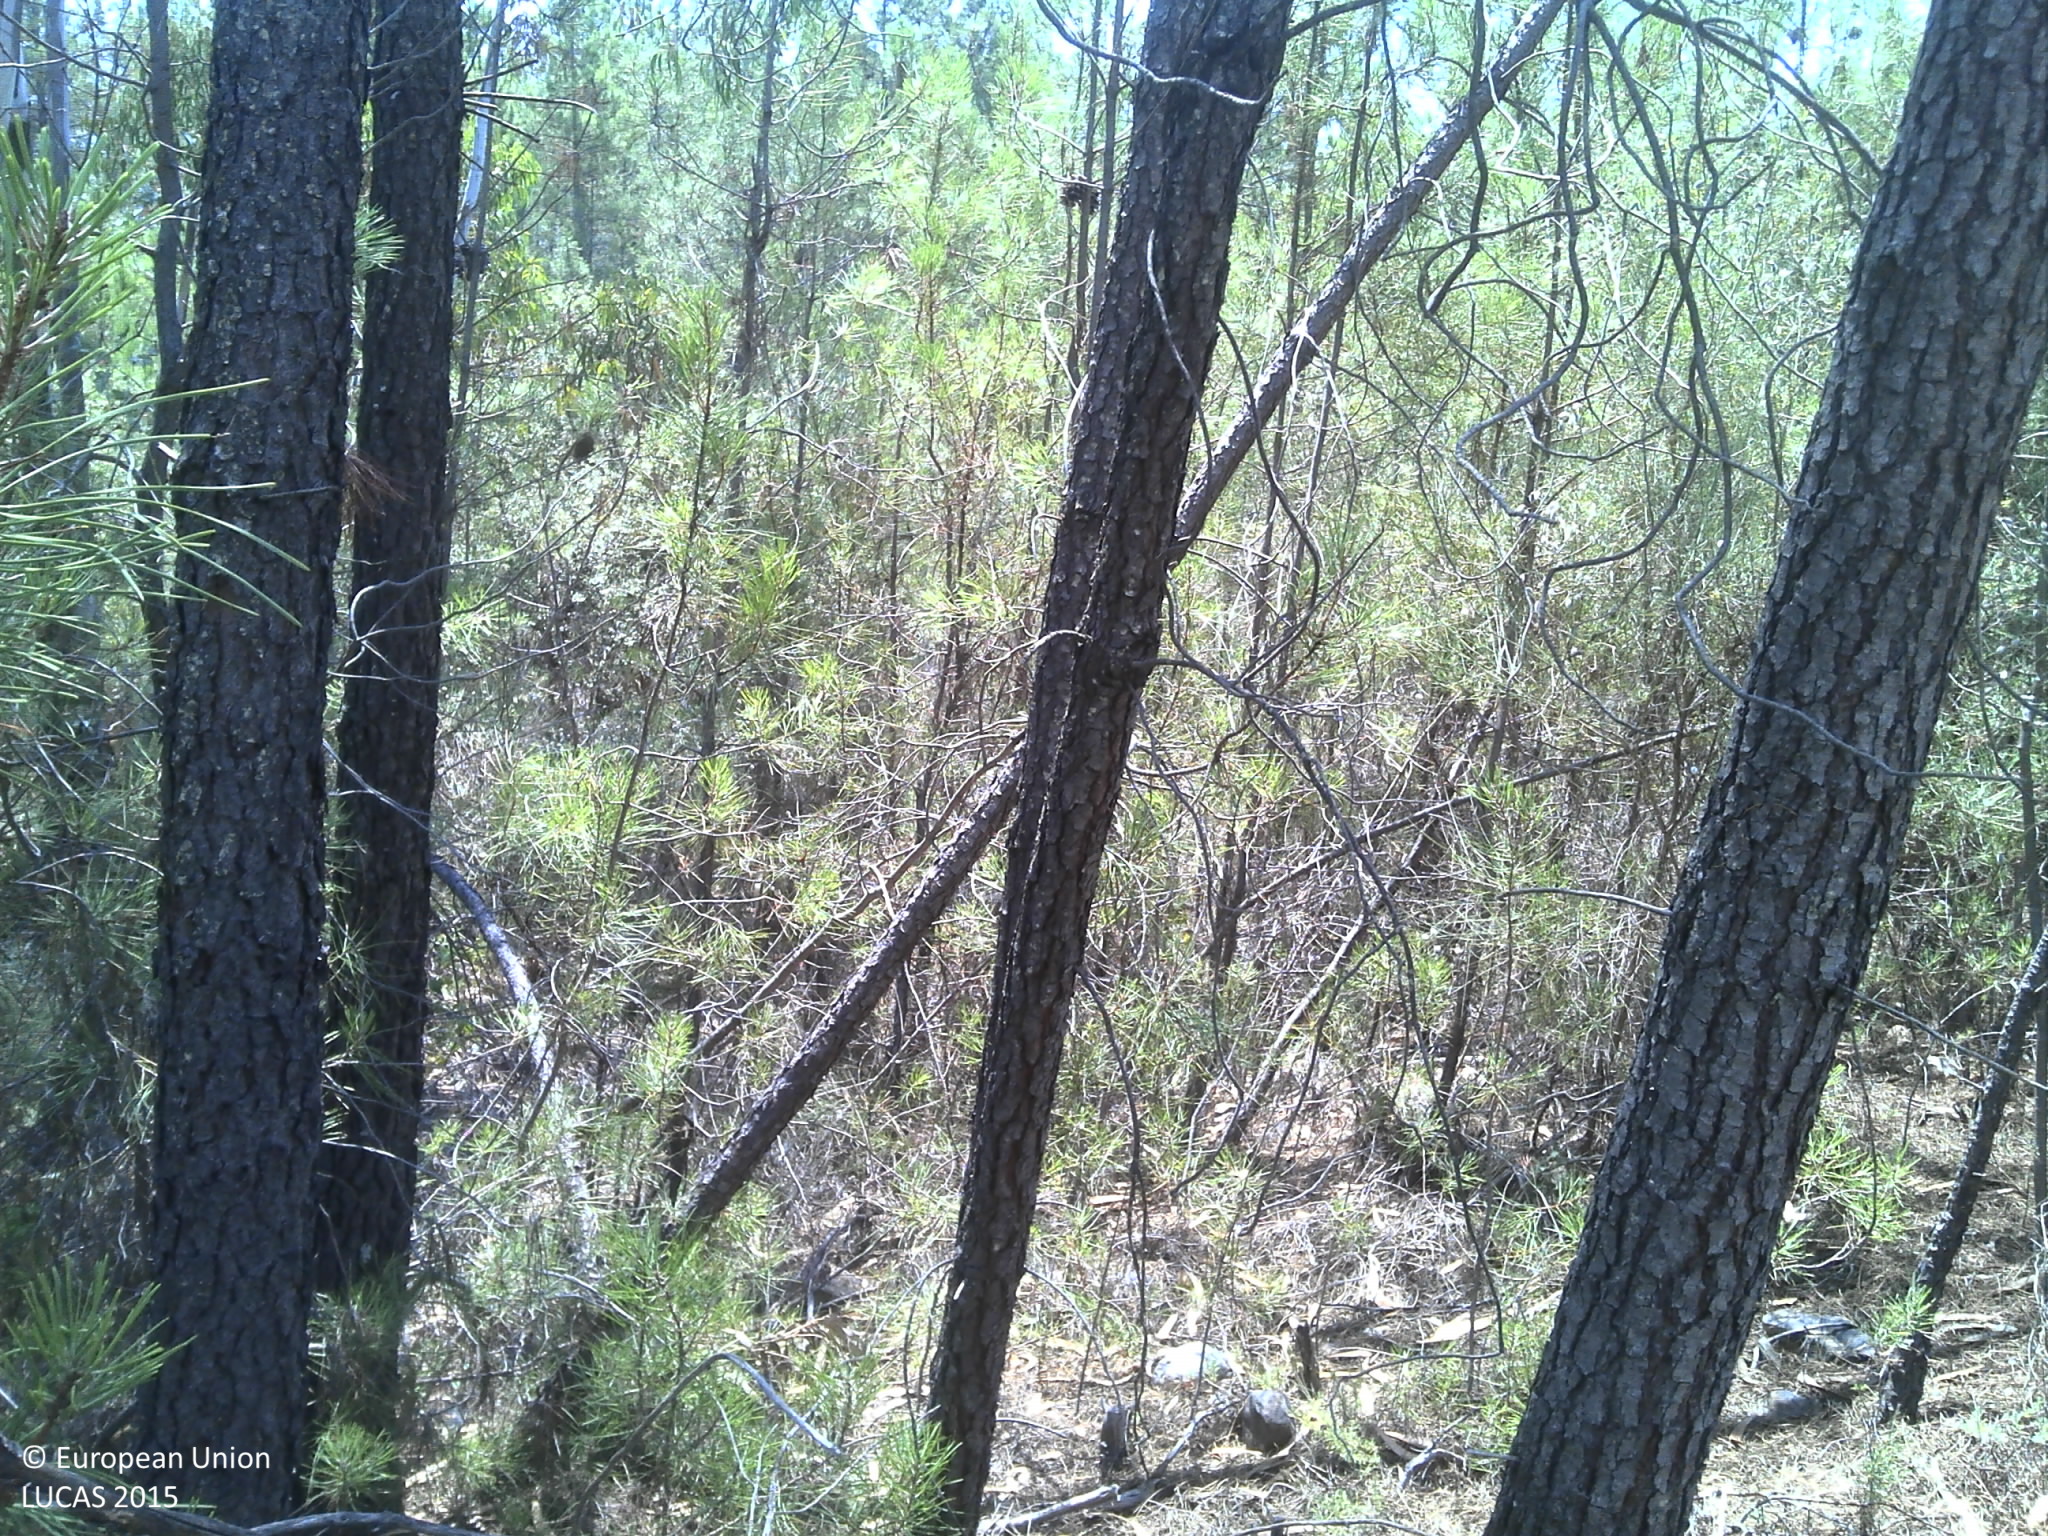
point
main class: Woodland
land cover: Pine dominated coniferous woodland
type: coniferous forest of the mediterranean region
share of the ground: > 75 %
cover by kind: coniferous forest trees 75 %, shrubs 15 %, unconsolidated bare surface 5 %
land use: Forestry
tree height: > 5 m
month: June
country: PT
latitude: 39.9469
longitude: -7.0262
